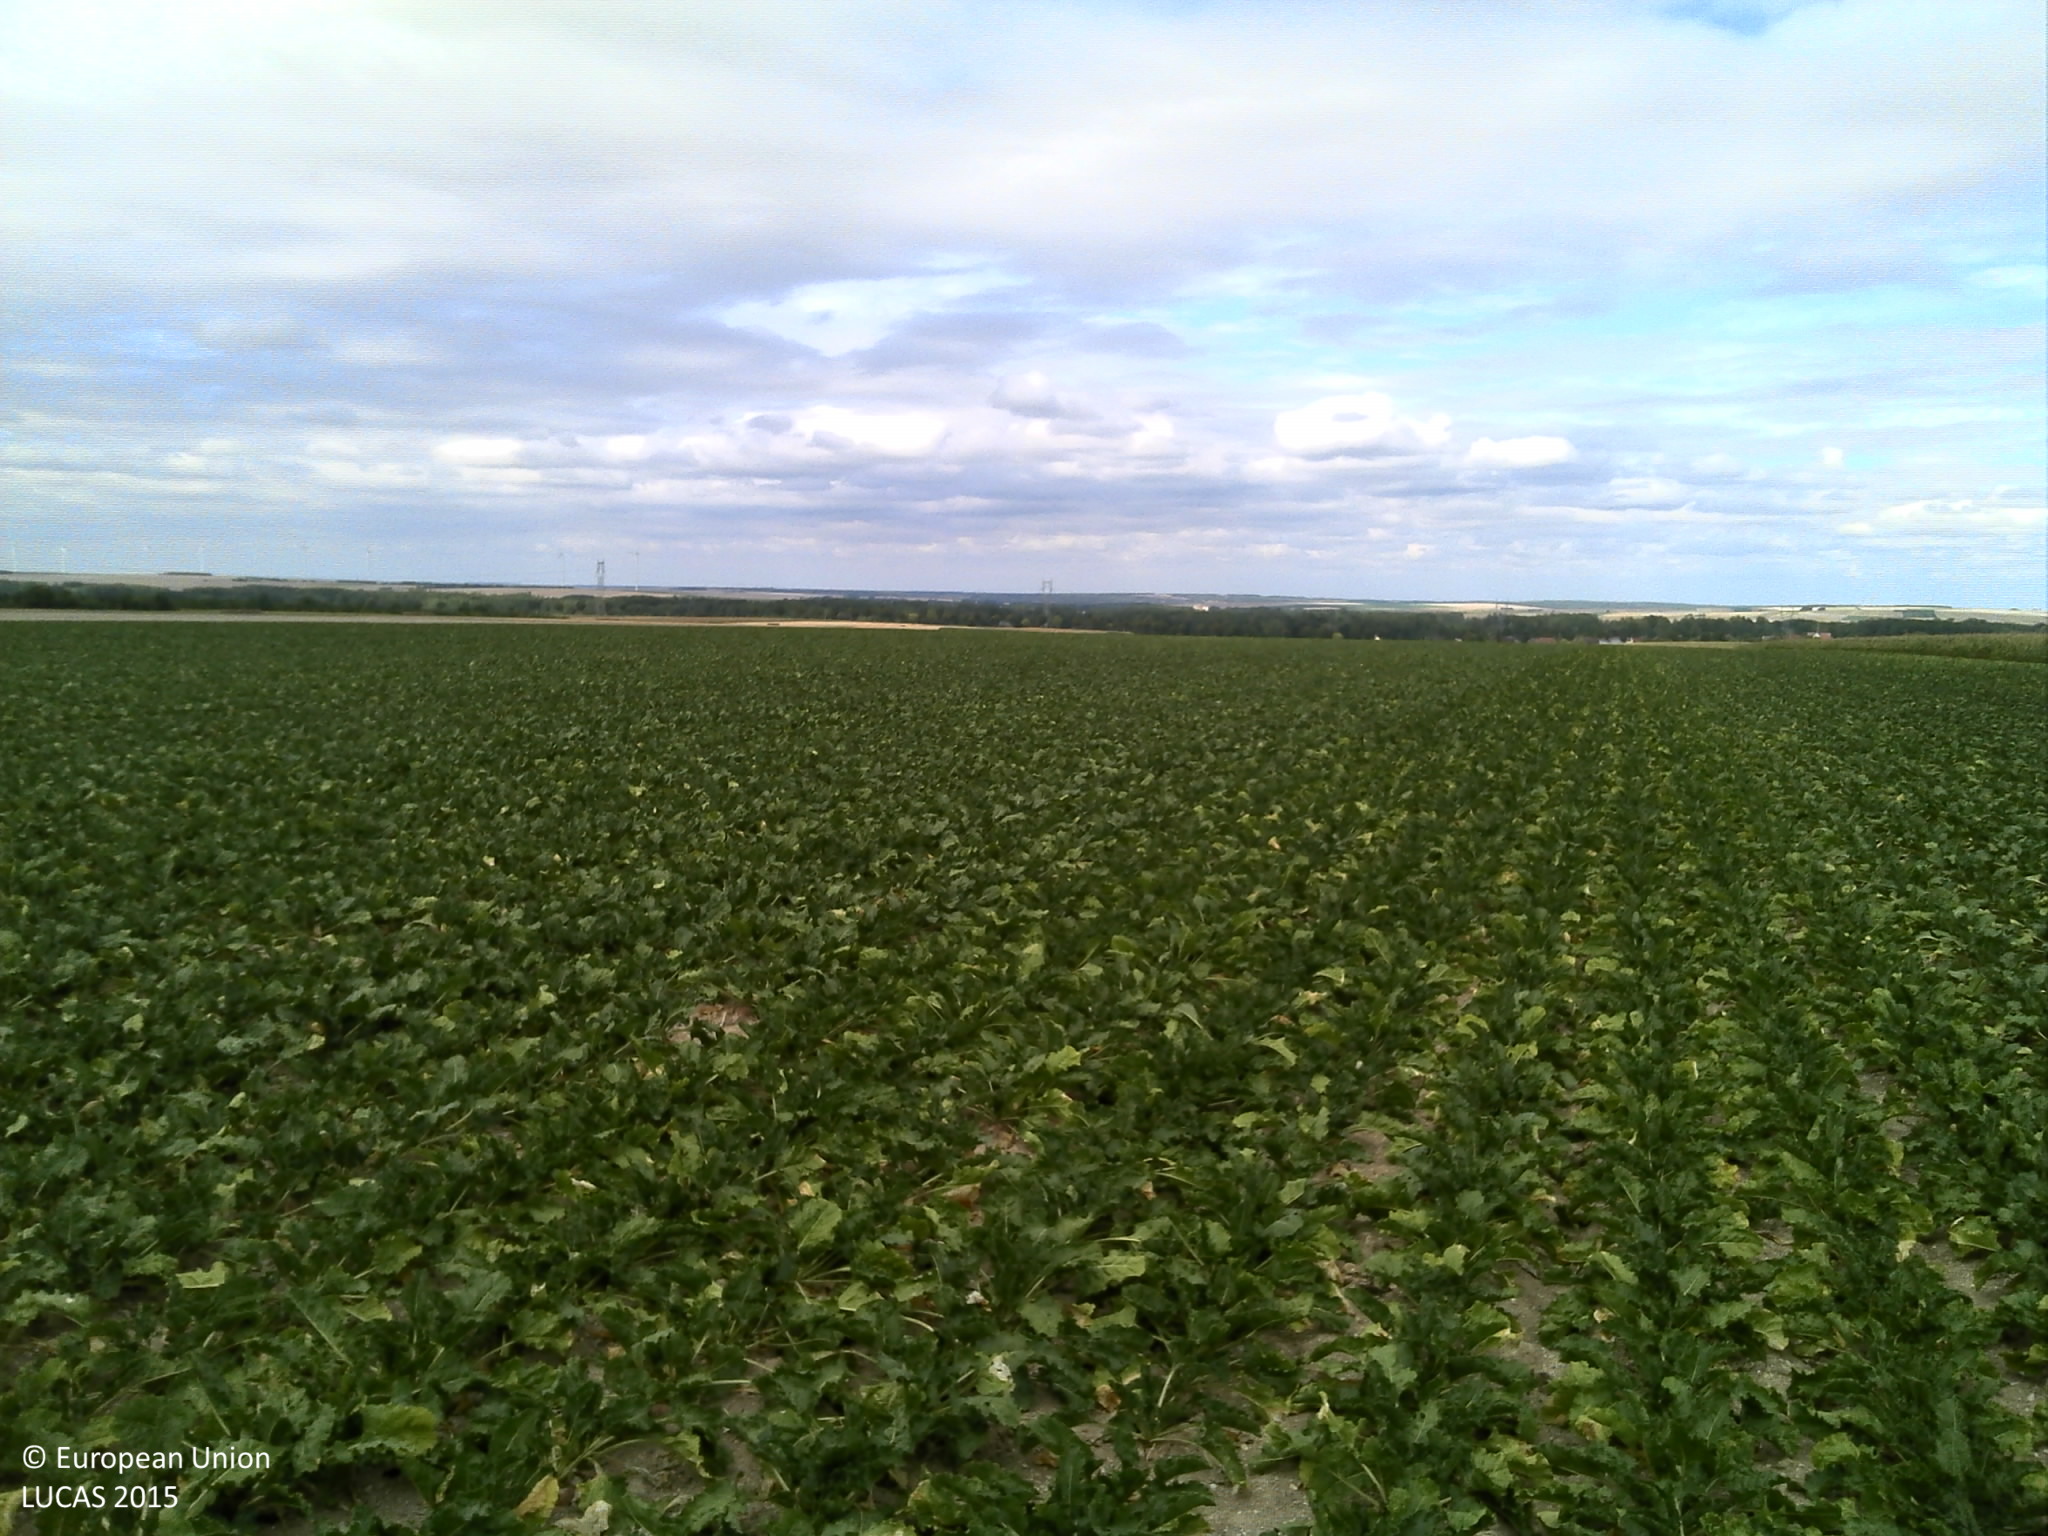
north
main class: Cropland
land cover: Sugar beet
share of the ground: 50 - 75 %
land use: Agriculture (excluding fallow land and kitchen gardens)
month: August
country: FR
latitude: 48.5047
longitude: 4.2170
